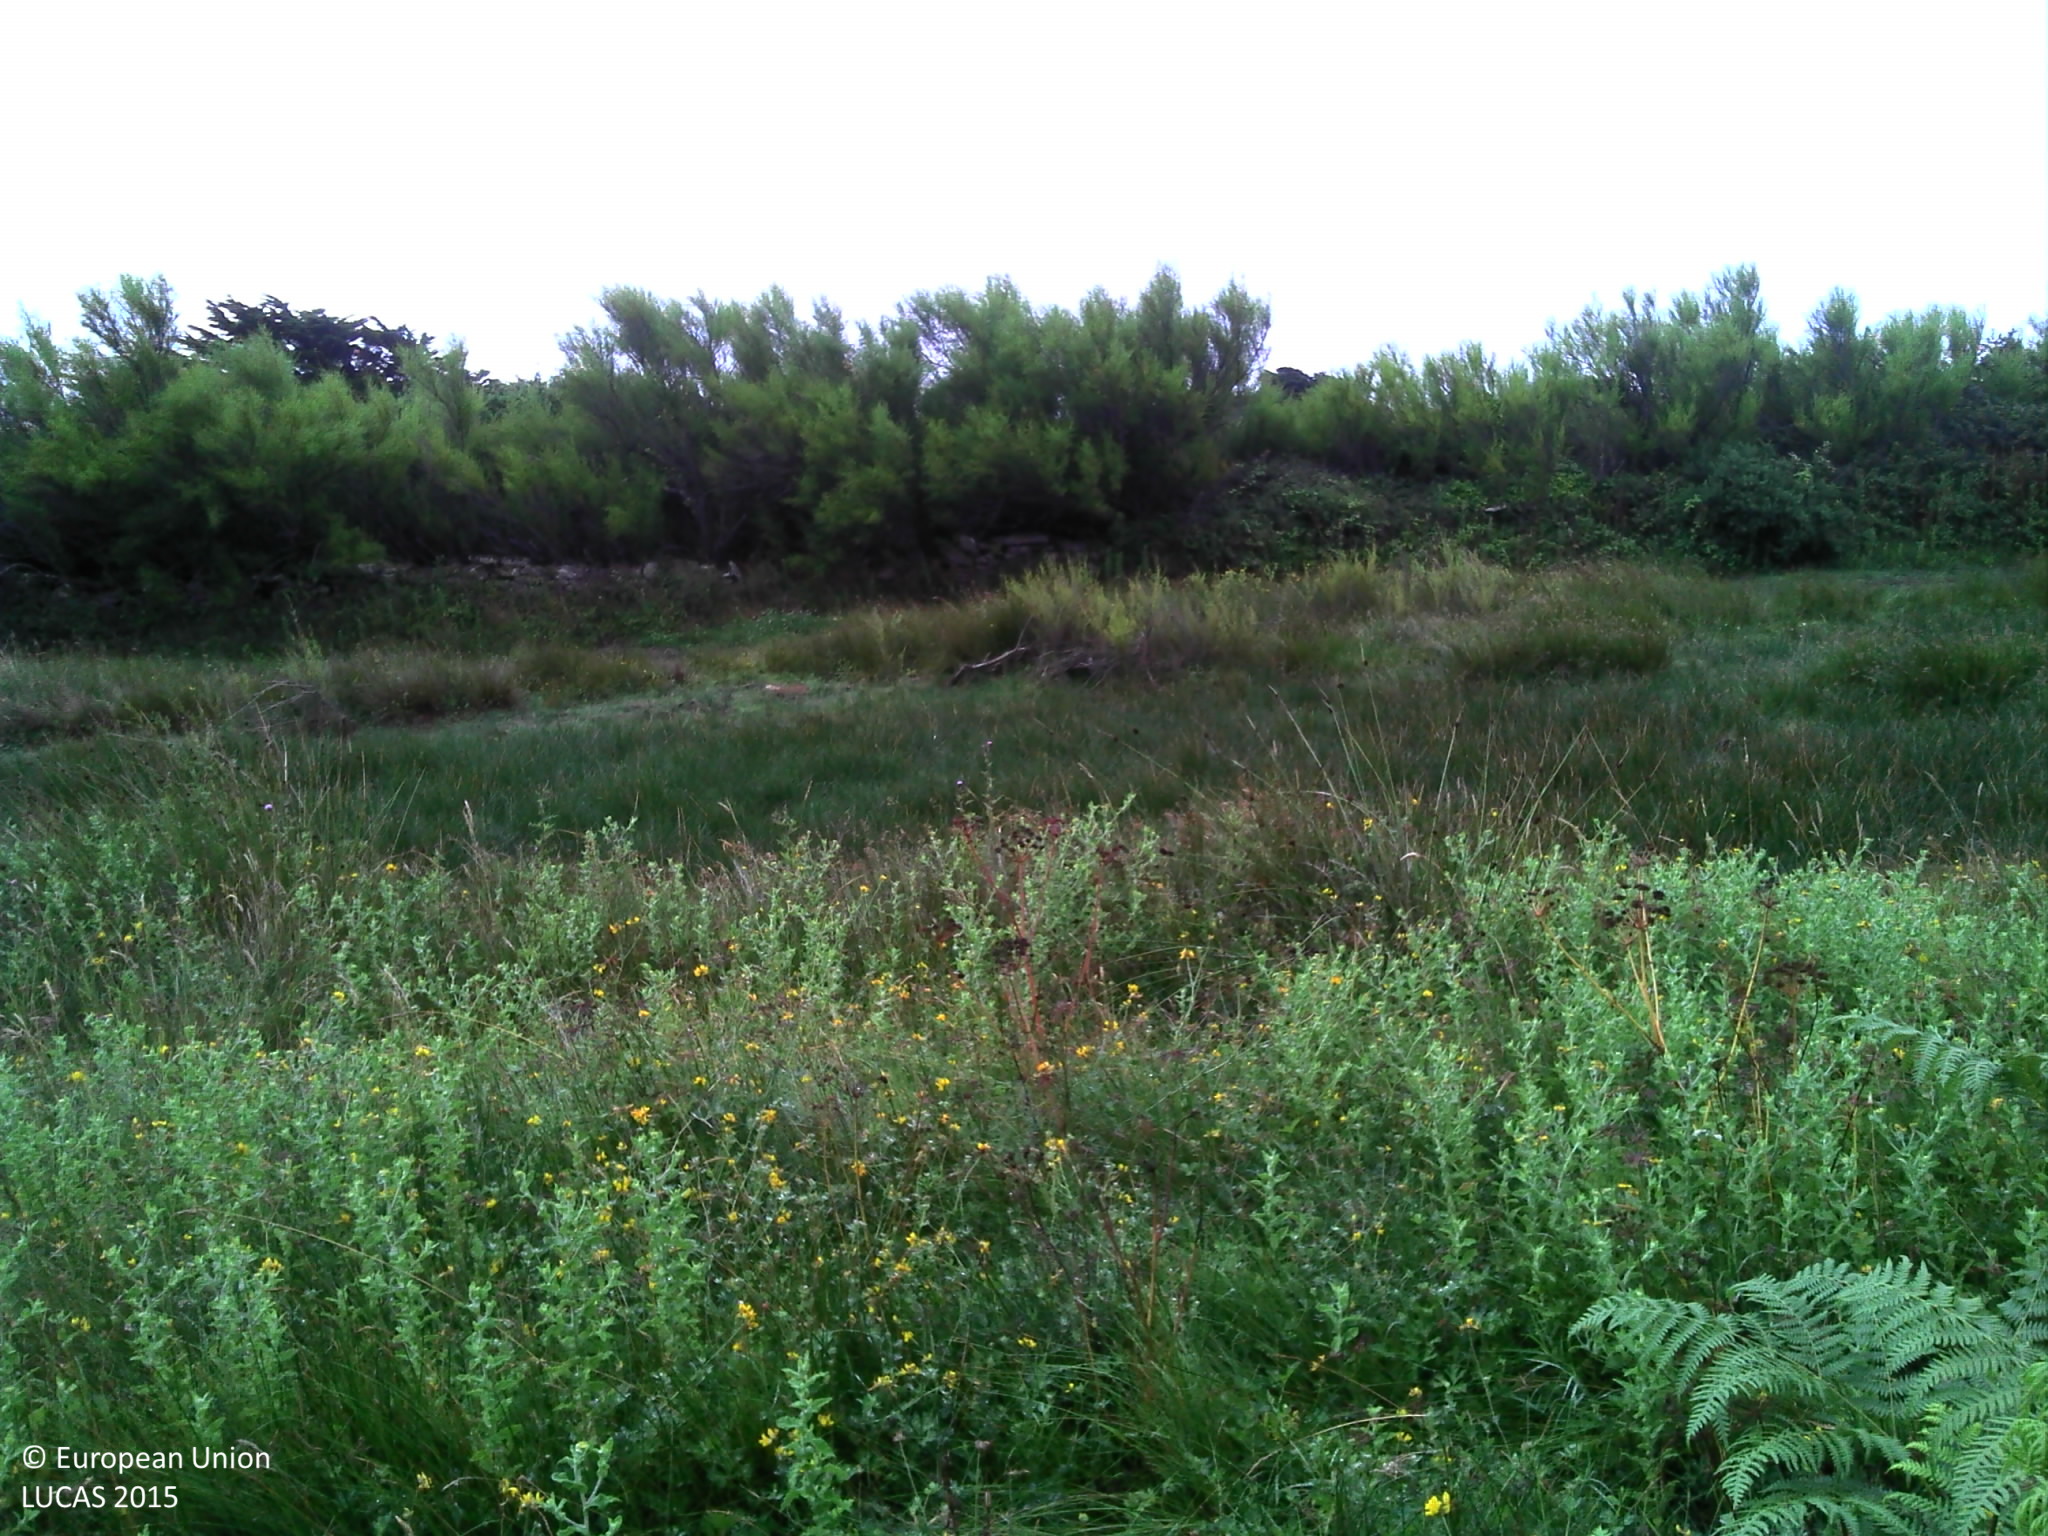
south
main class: Shrubland
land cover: Shrubland without tree cover
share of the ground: > 75 %
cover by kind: shrubs 60 %, herbaceous plants 30 %, consolidated bare surface 10 %
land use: Semi-natural and natural areas not in use
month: July
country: FR
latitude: 47.5052
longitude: -3.1449
